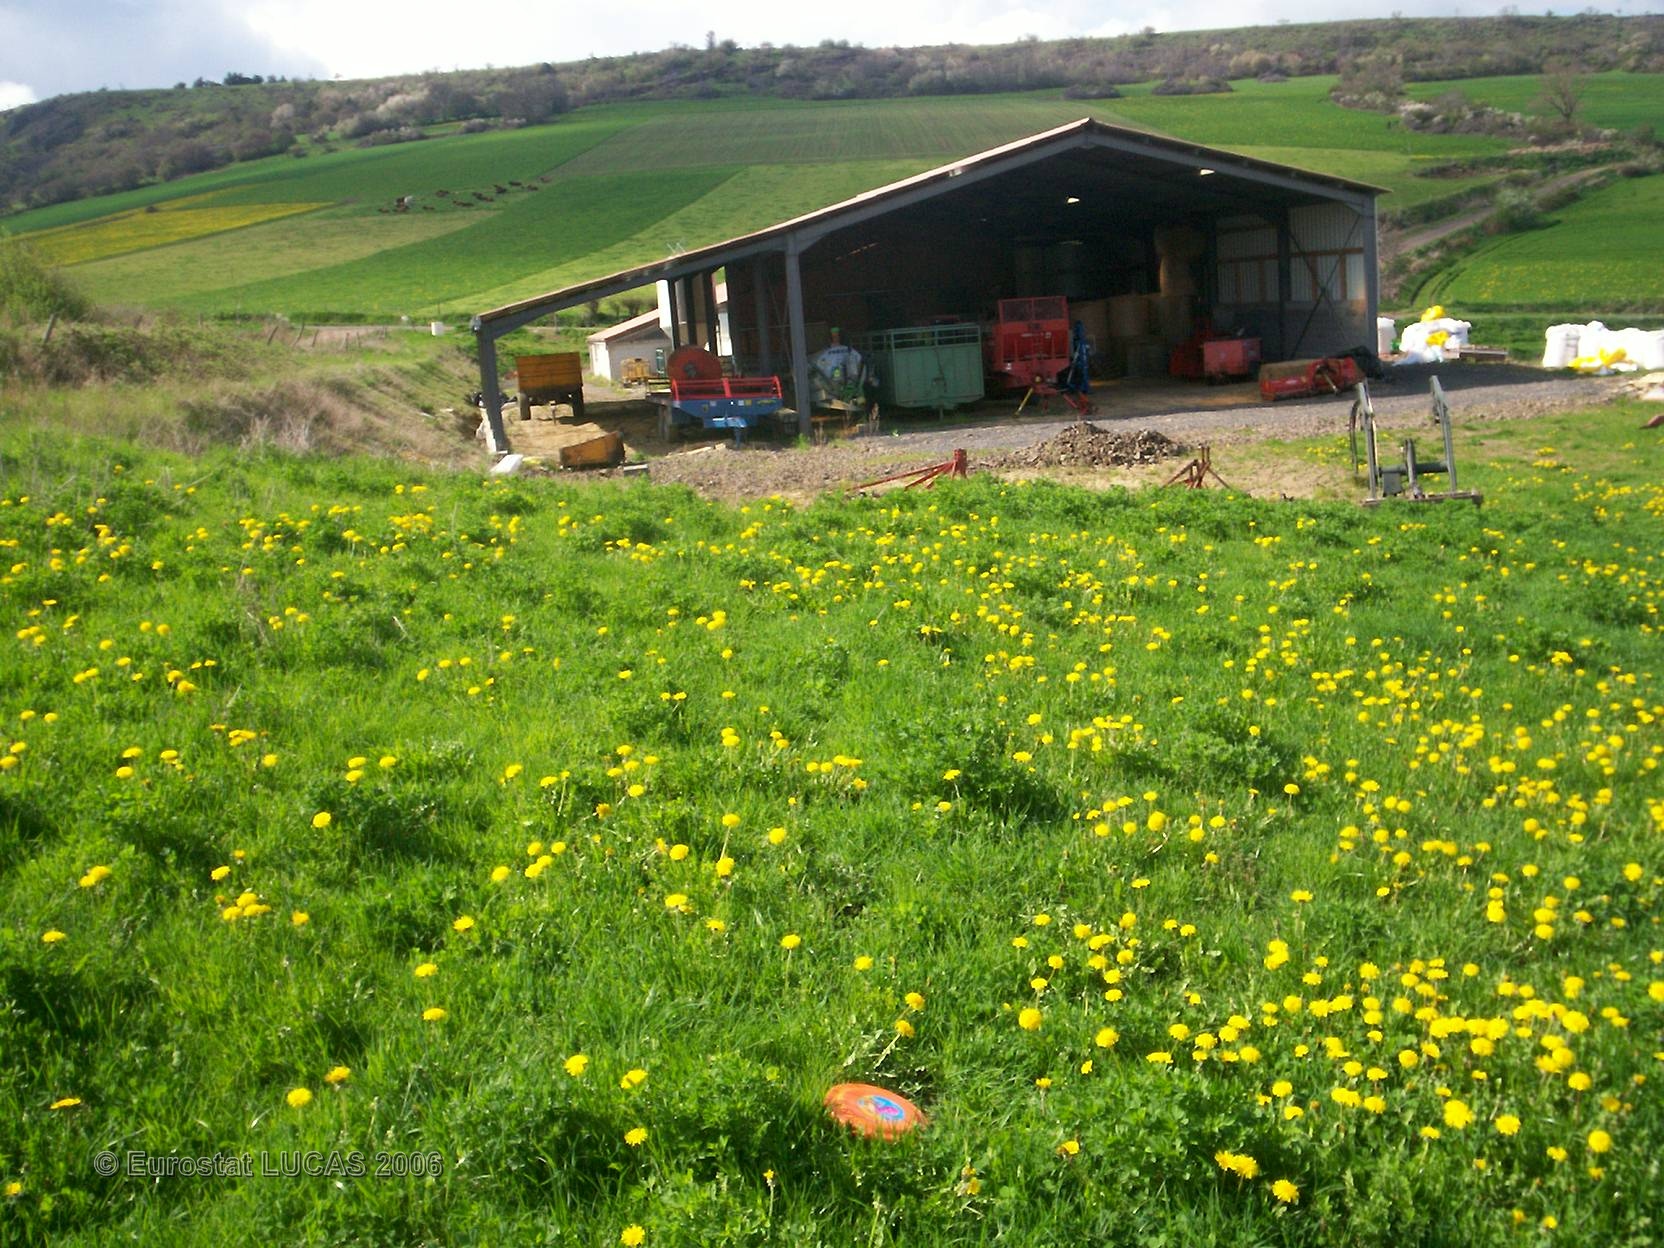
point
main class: Grassland
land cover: Grassland without tree/shrub cover
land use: Agriculture (excluding fallow land and kitchen gardens)
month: April
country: FR
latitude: 45.4257
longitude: 3.1377
